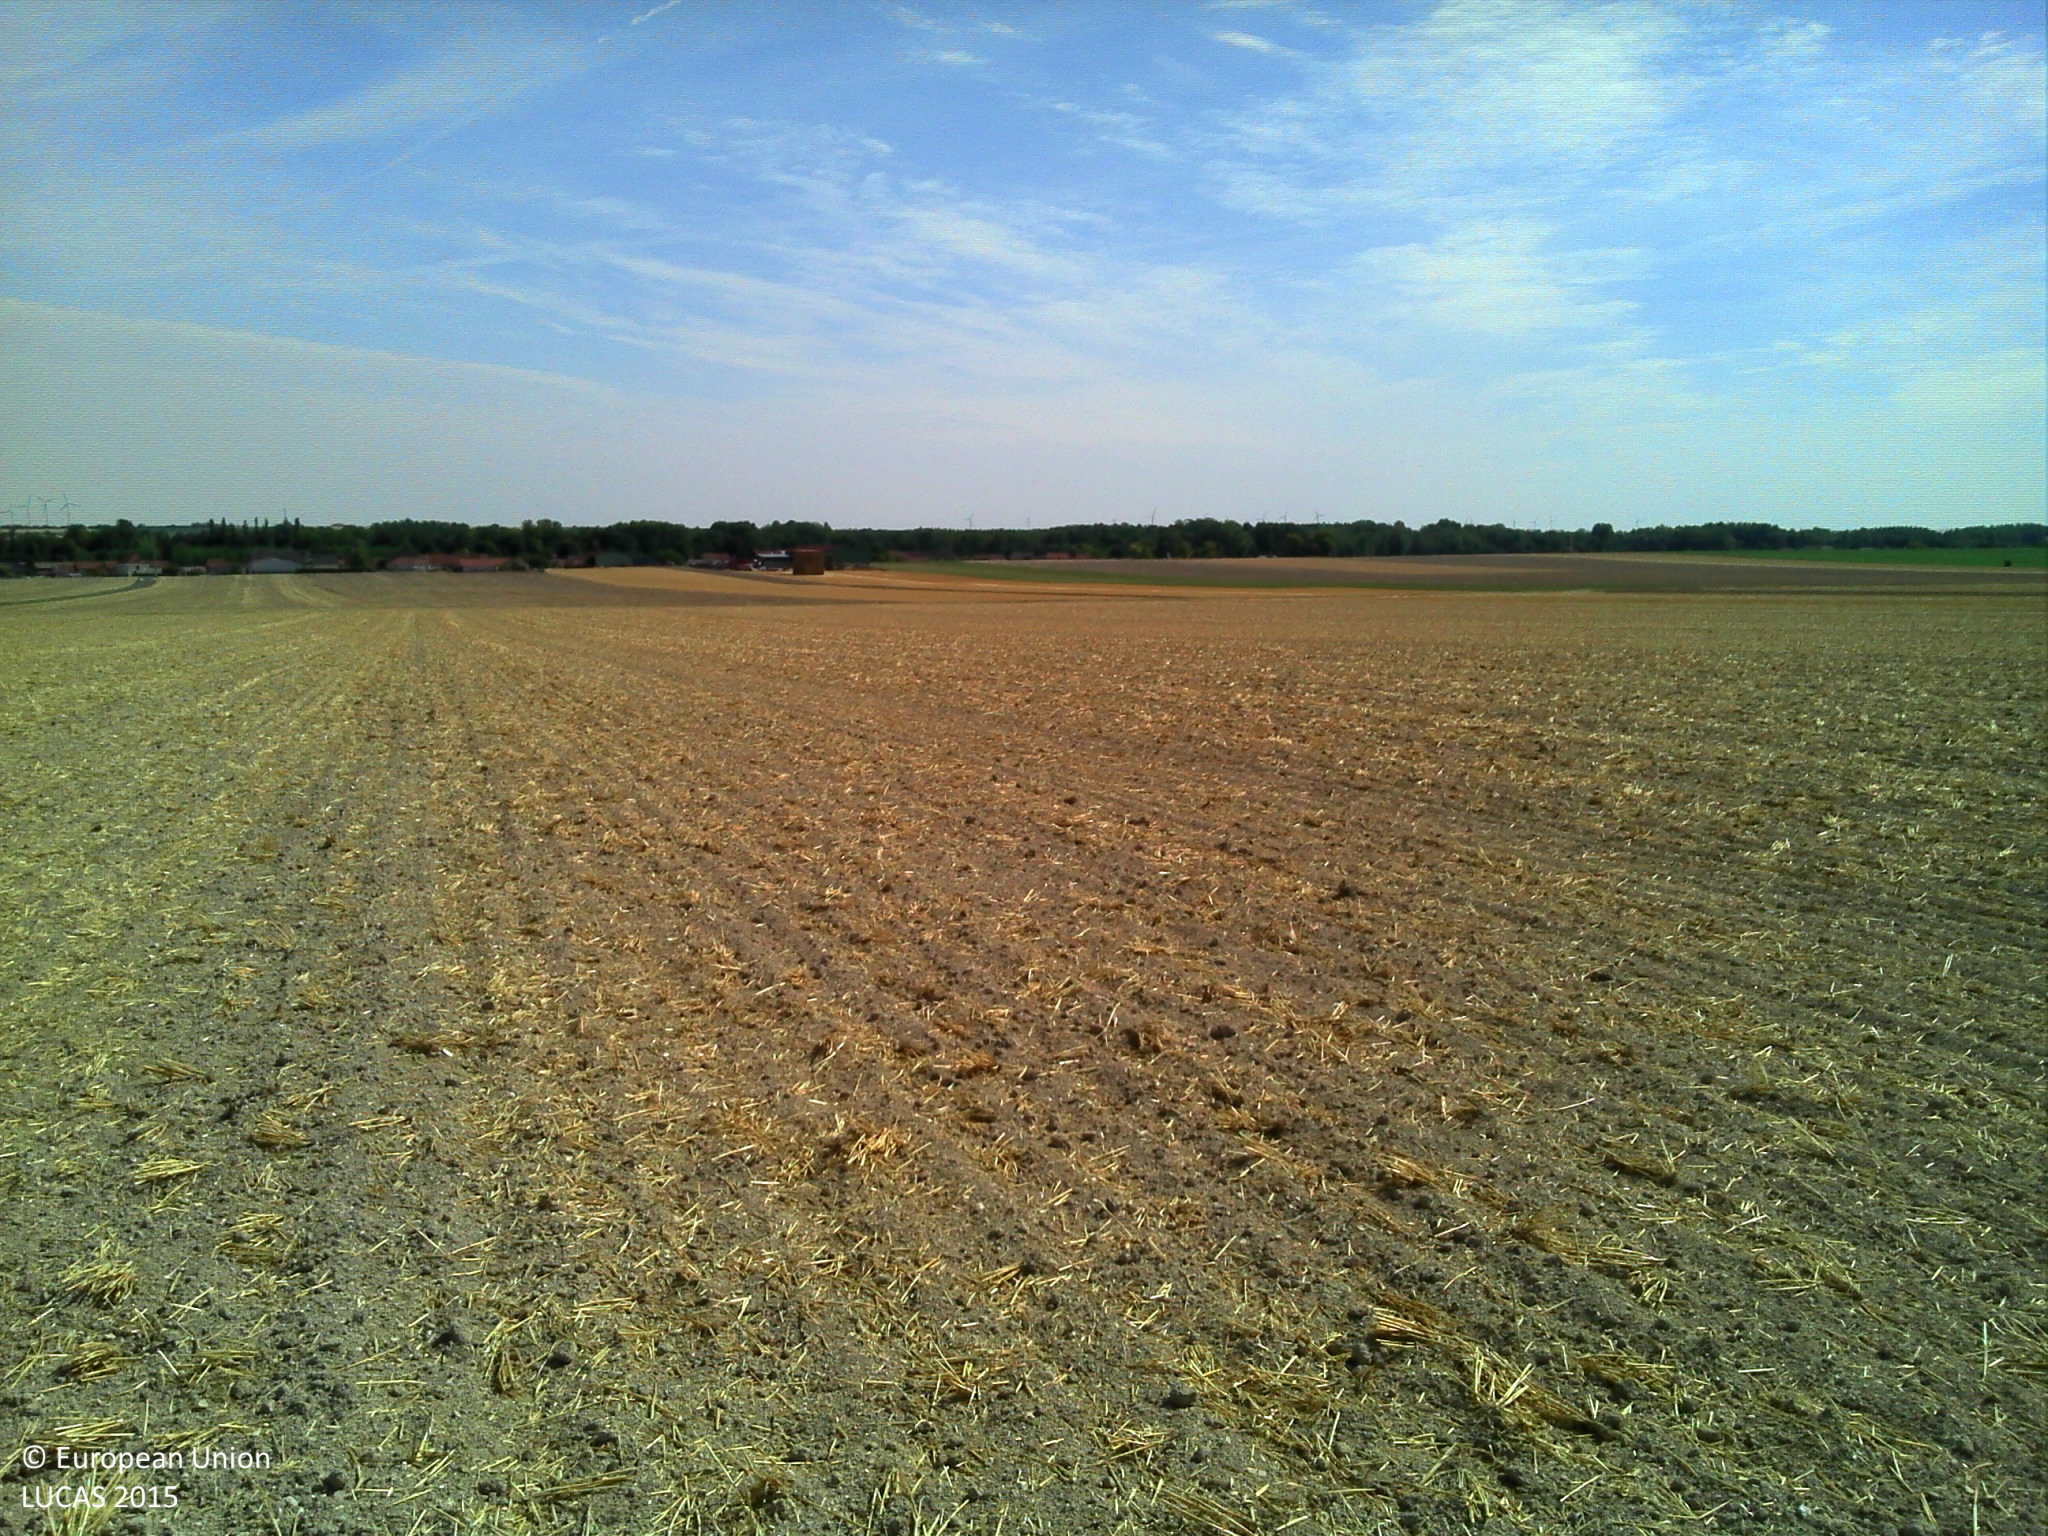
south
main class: Cropland
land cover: Common wheat
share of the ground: > 75 %
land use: Agriculture (excluding fallow land and kitchen gardens)
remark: Tilled/Sowed
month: August
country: FR
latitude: 48.9500
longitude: 4.1102
